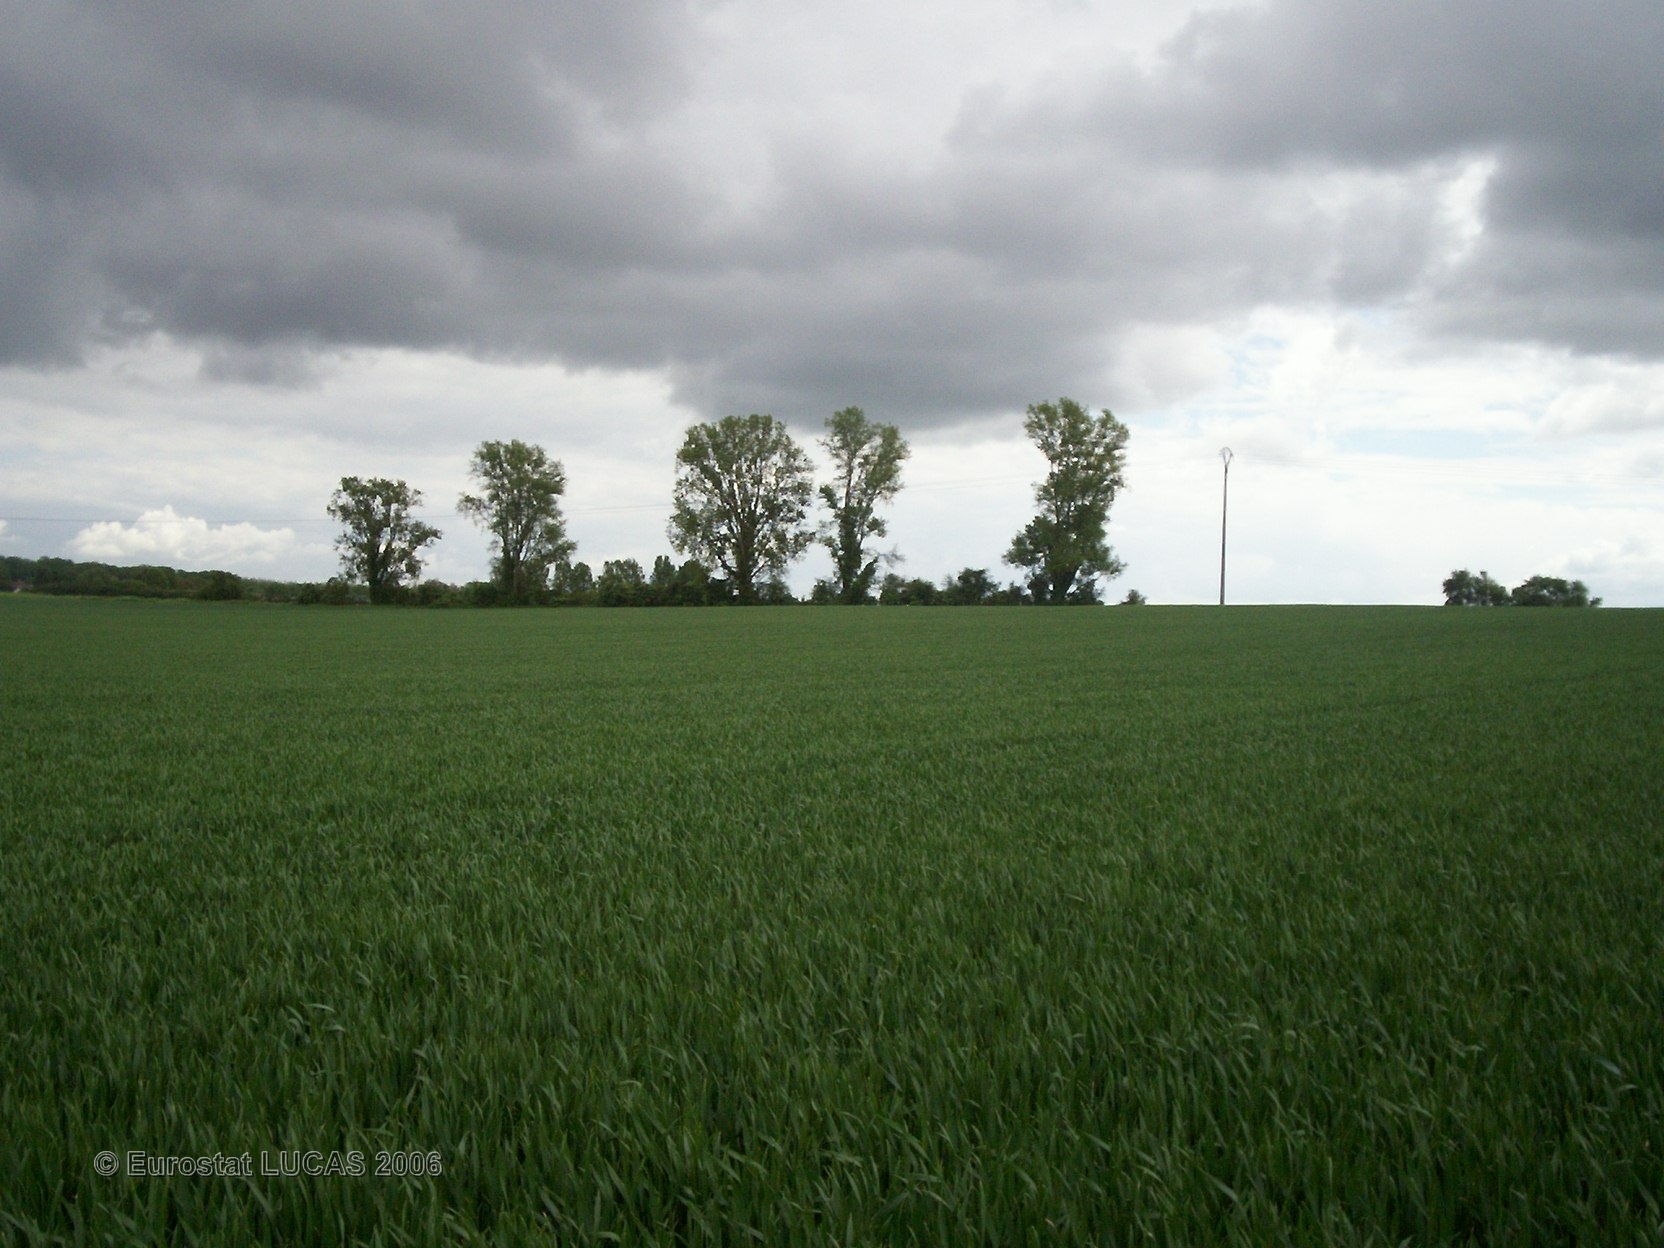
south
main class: Cropland
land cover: Common wheat
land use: Agriculture (excluding fallow land and kitchen gardens)
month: May
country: FR
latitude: 49.7820
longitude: 2.6137
